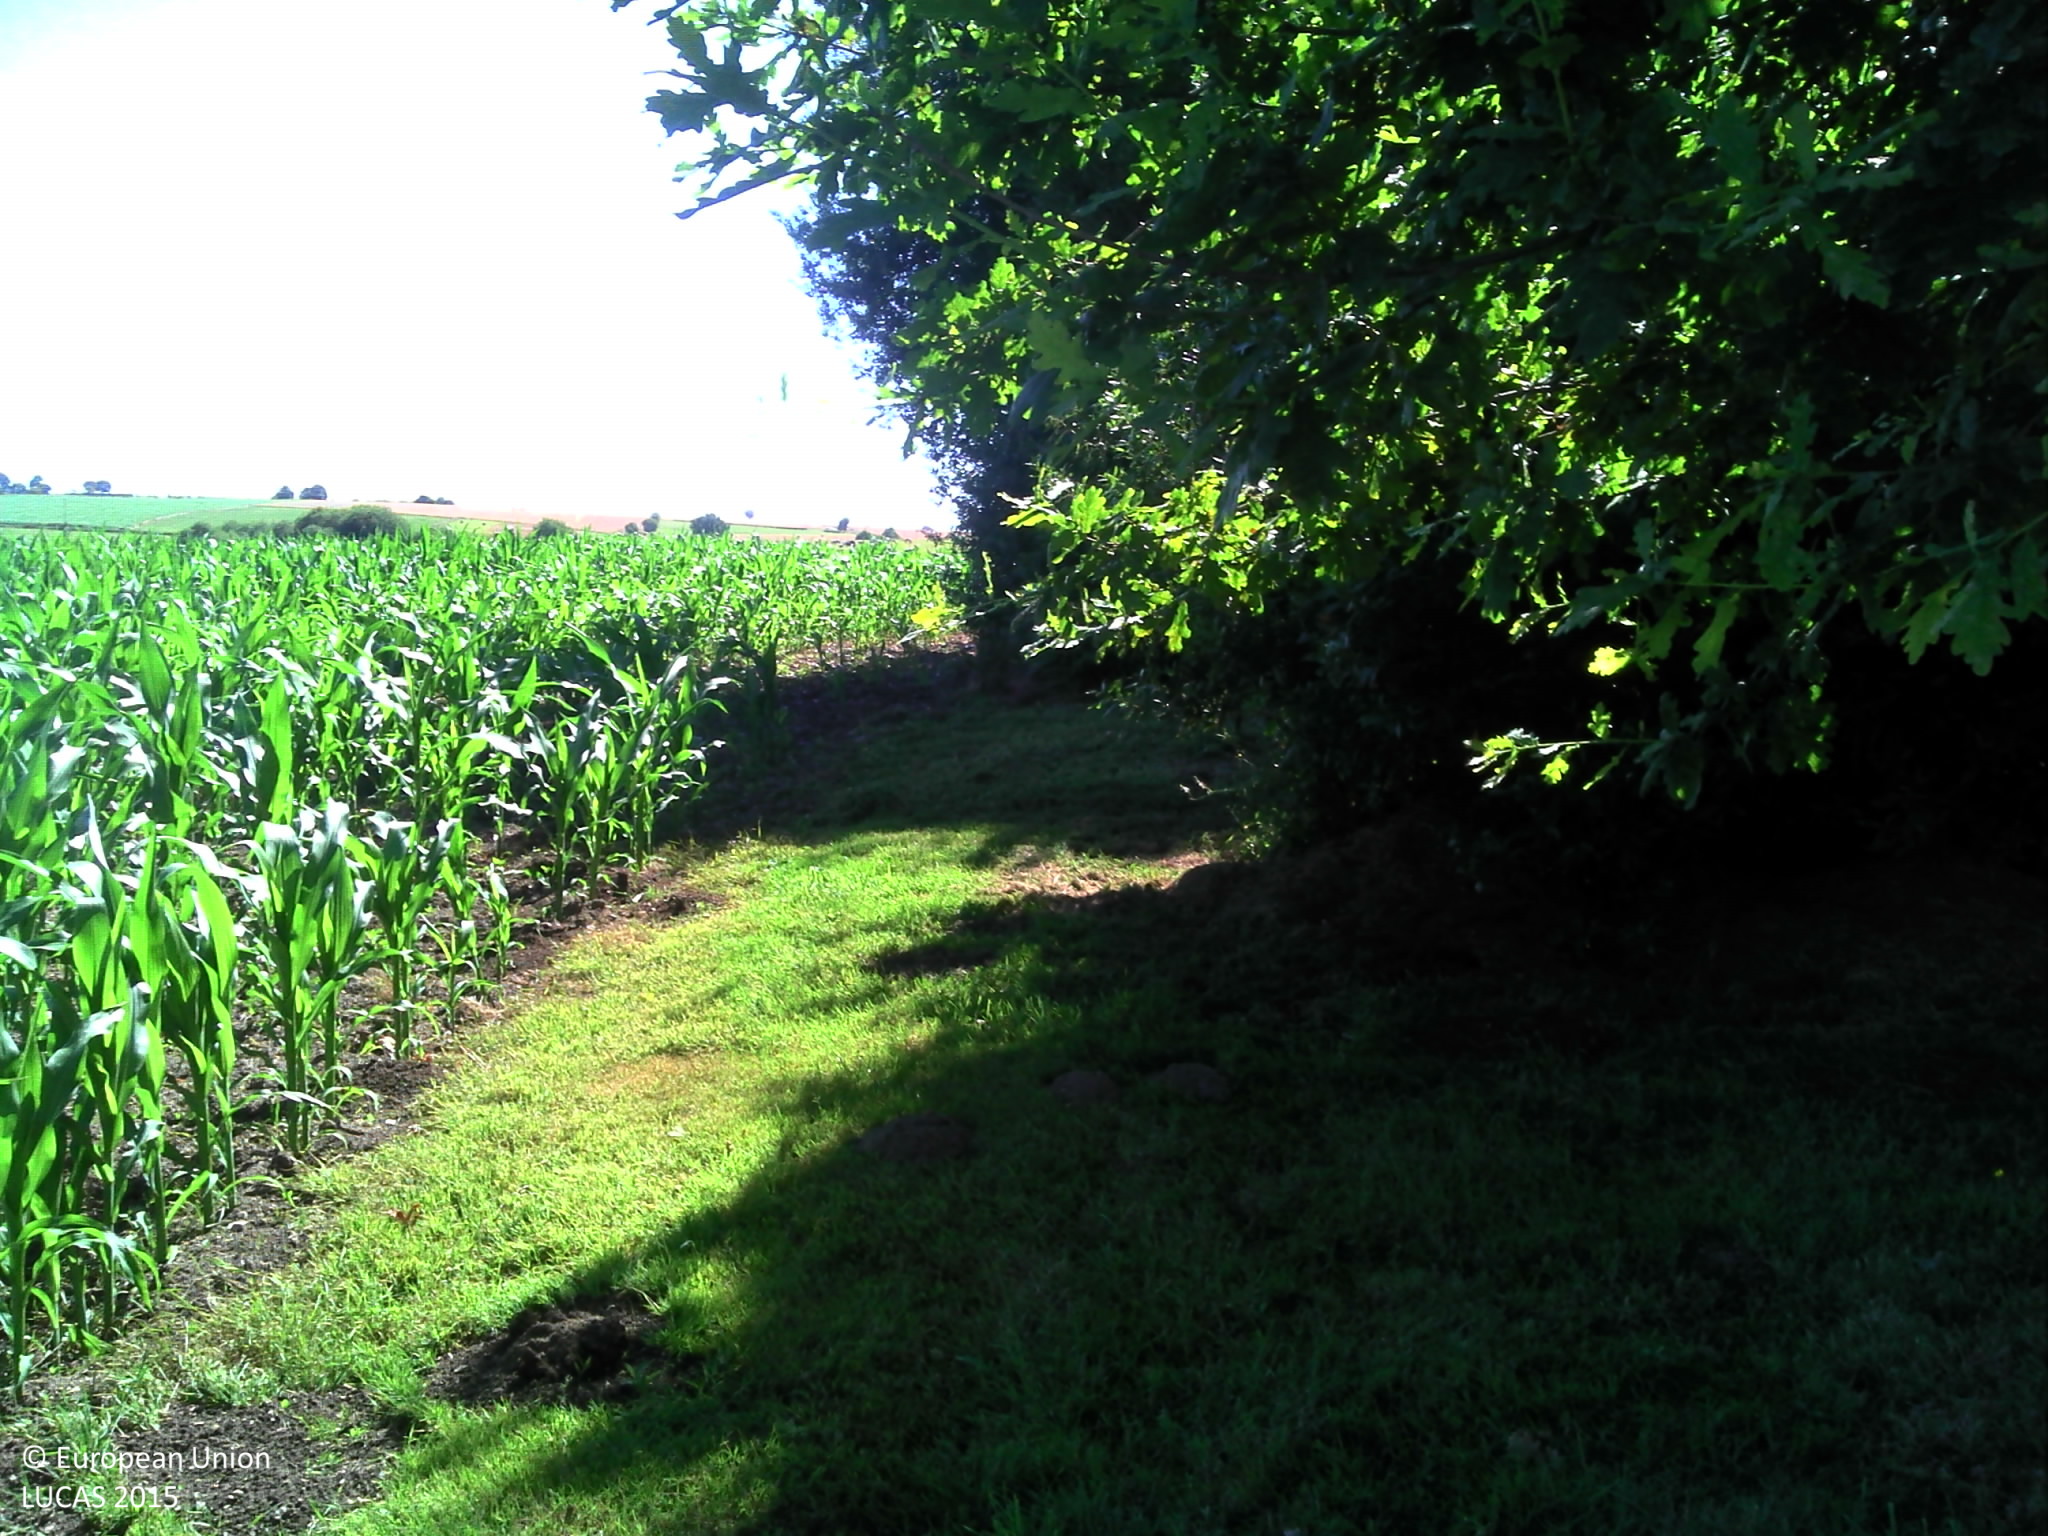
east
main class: Woodland
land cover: Broadleaved woodland
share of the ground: > 75 %
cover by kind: herbaceous plants 80 %, broadleaved forest trees 20 %
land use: Residential
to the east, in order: Broadleaved woodland; Grassland without tree/shrub cover; Single bushes/trees; Maize; Grassland without tree/shrub cover; Inland fresh water bodies; Grass margins; Broadleaved woodland
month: July
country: FR
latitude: 47.7485
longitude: -1.9883
